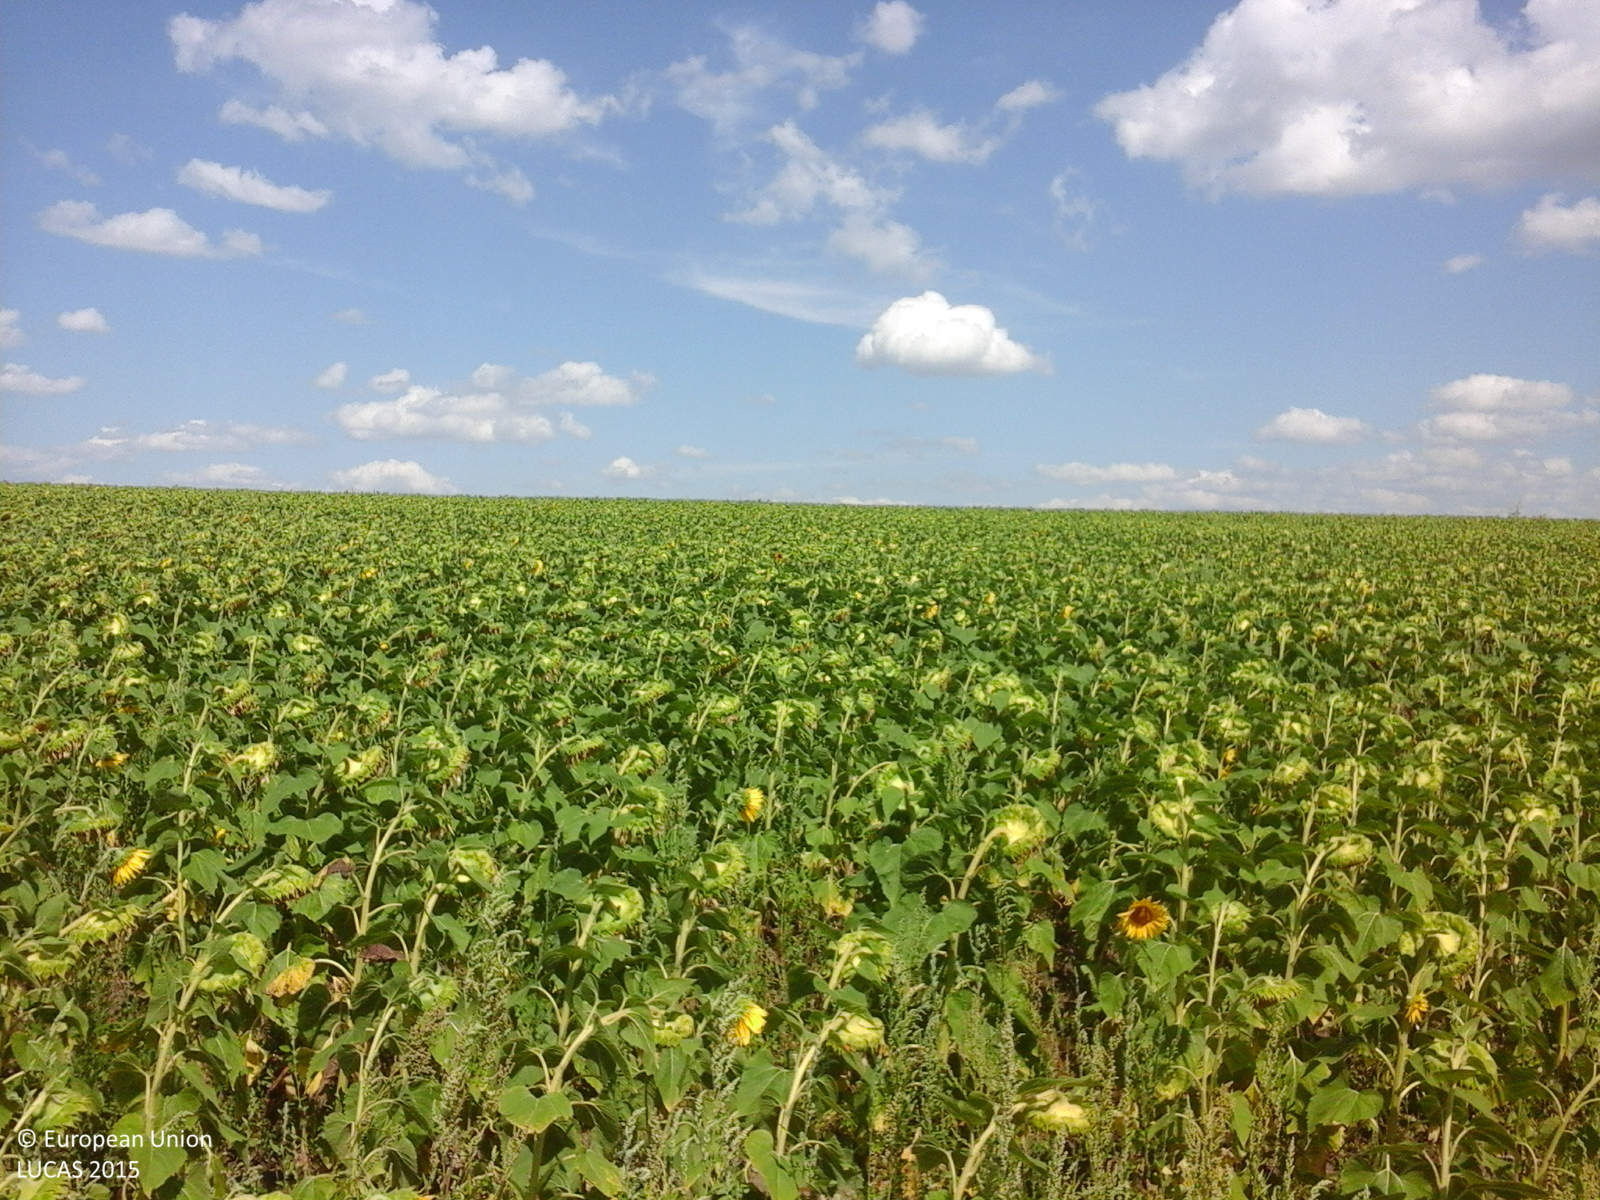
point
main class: Cropland
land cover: Sunflower
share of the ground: > 75 %
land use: Agriculture (excluding fallow land and kitchen gardens)
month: July
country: RO
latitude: 46.4618
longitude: 28.1389
